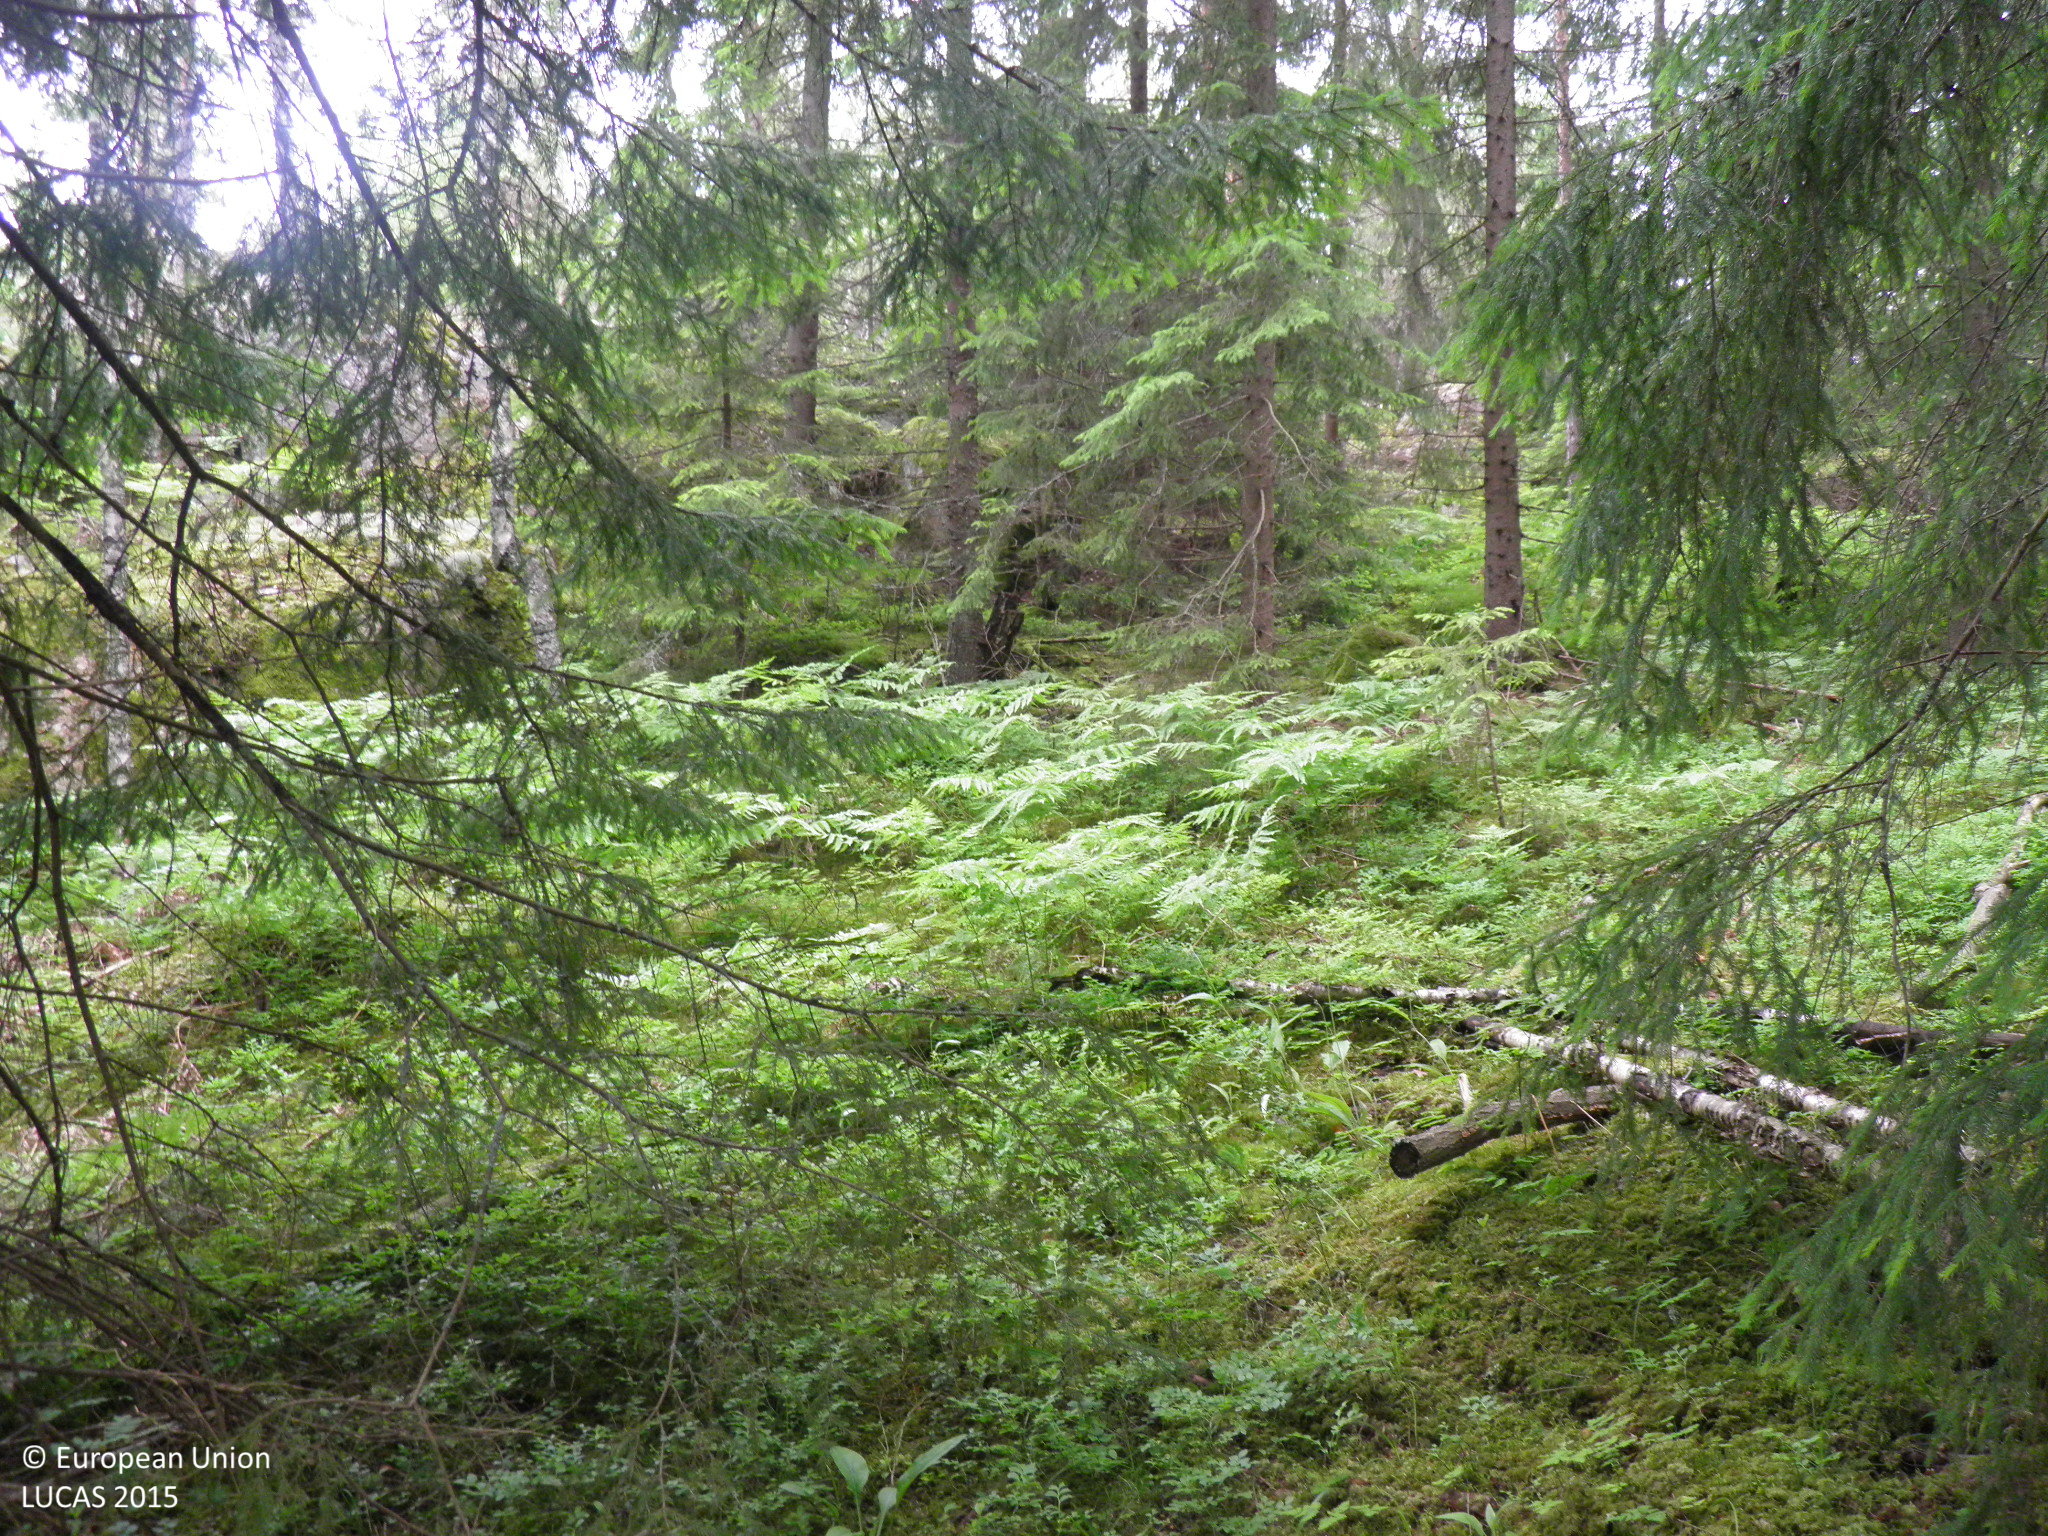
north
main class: Woodland
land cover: Spruce dominated coniferous woodland
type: hemiboreal forest and nemoral coniferous forest and mixed broadleaved-coniferous forest
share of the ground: > 75 %
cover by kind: coniferous forest trees 70 %, broadleaved forest trees 10 %, herbaceous plants 10 %, shrubs 5 %, lichens and mosses 5 %
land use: Forestry
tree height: > 5 m
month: June
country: FI
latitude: 60.2725
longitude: 22.1616
